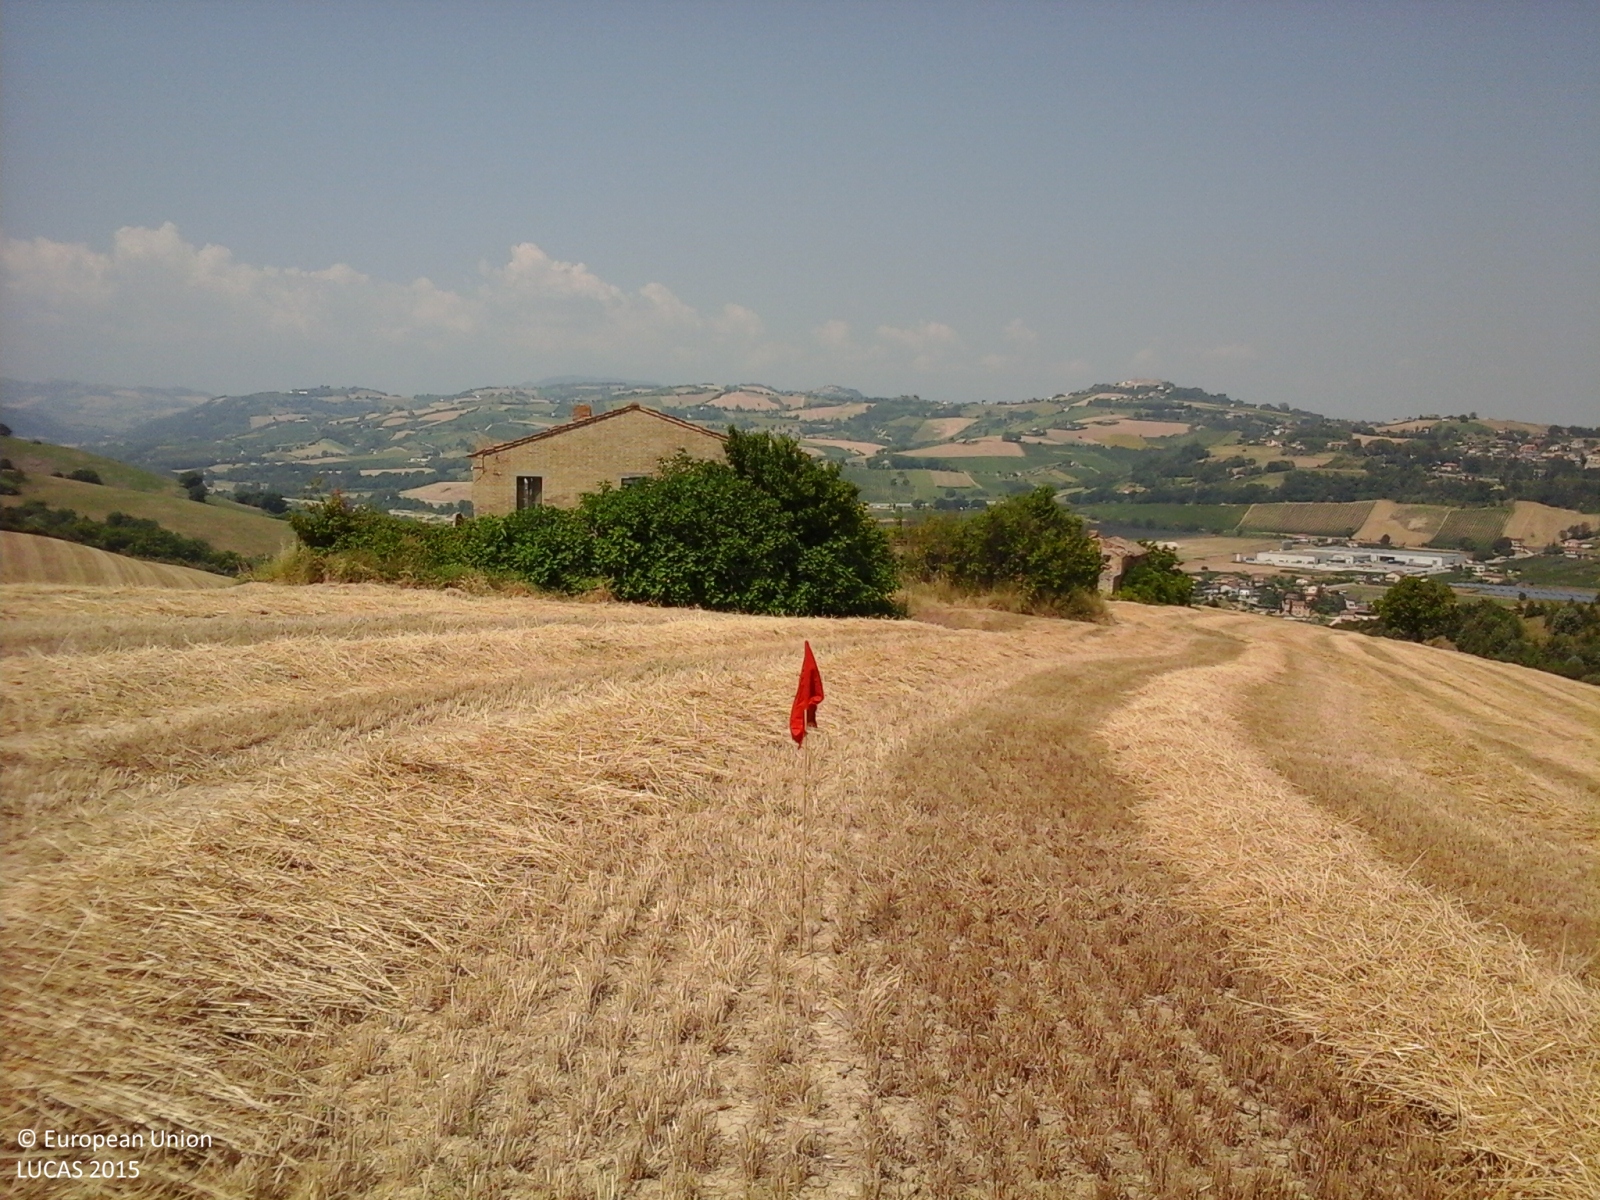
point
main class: Cropland
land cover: Durum wheat
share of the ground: > 75 %
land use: Agriculture (excluding fallow land and kitchen gardens)
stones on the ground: < 10 %
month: July
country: IT
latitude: 43.0226
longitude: 13.6347
